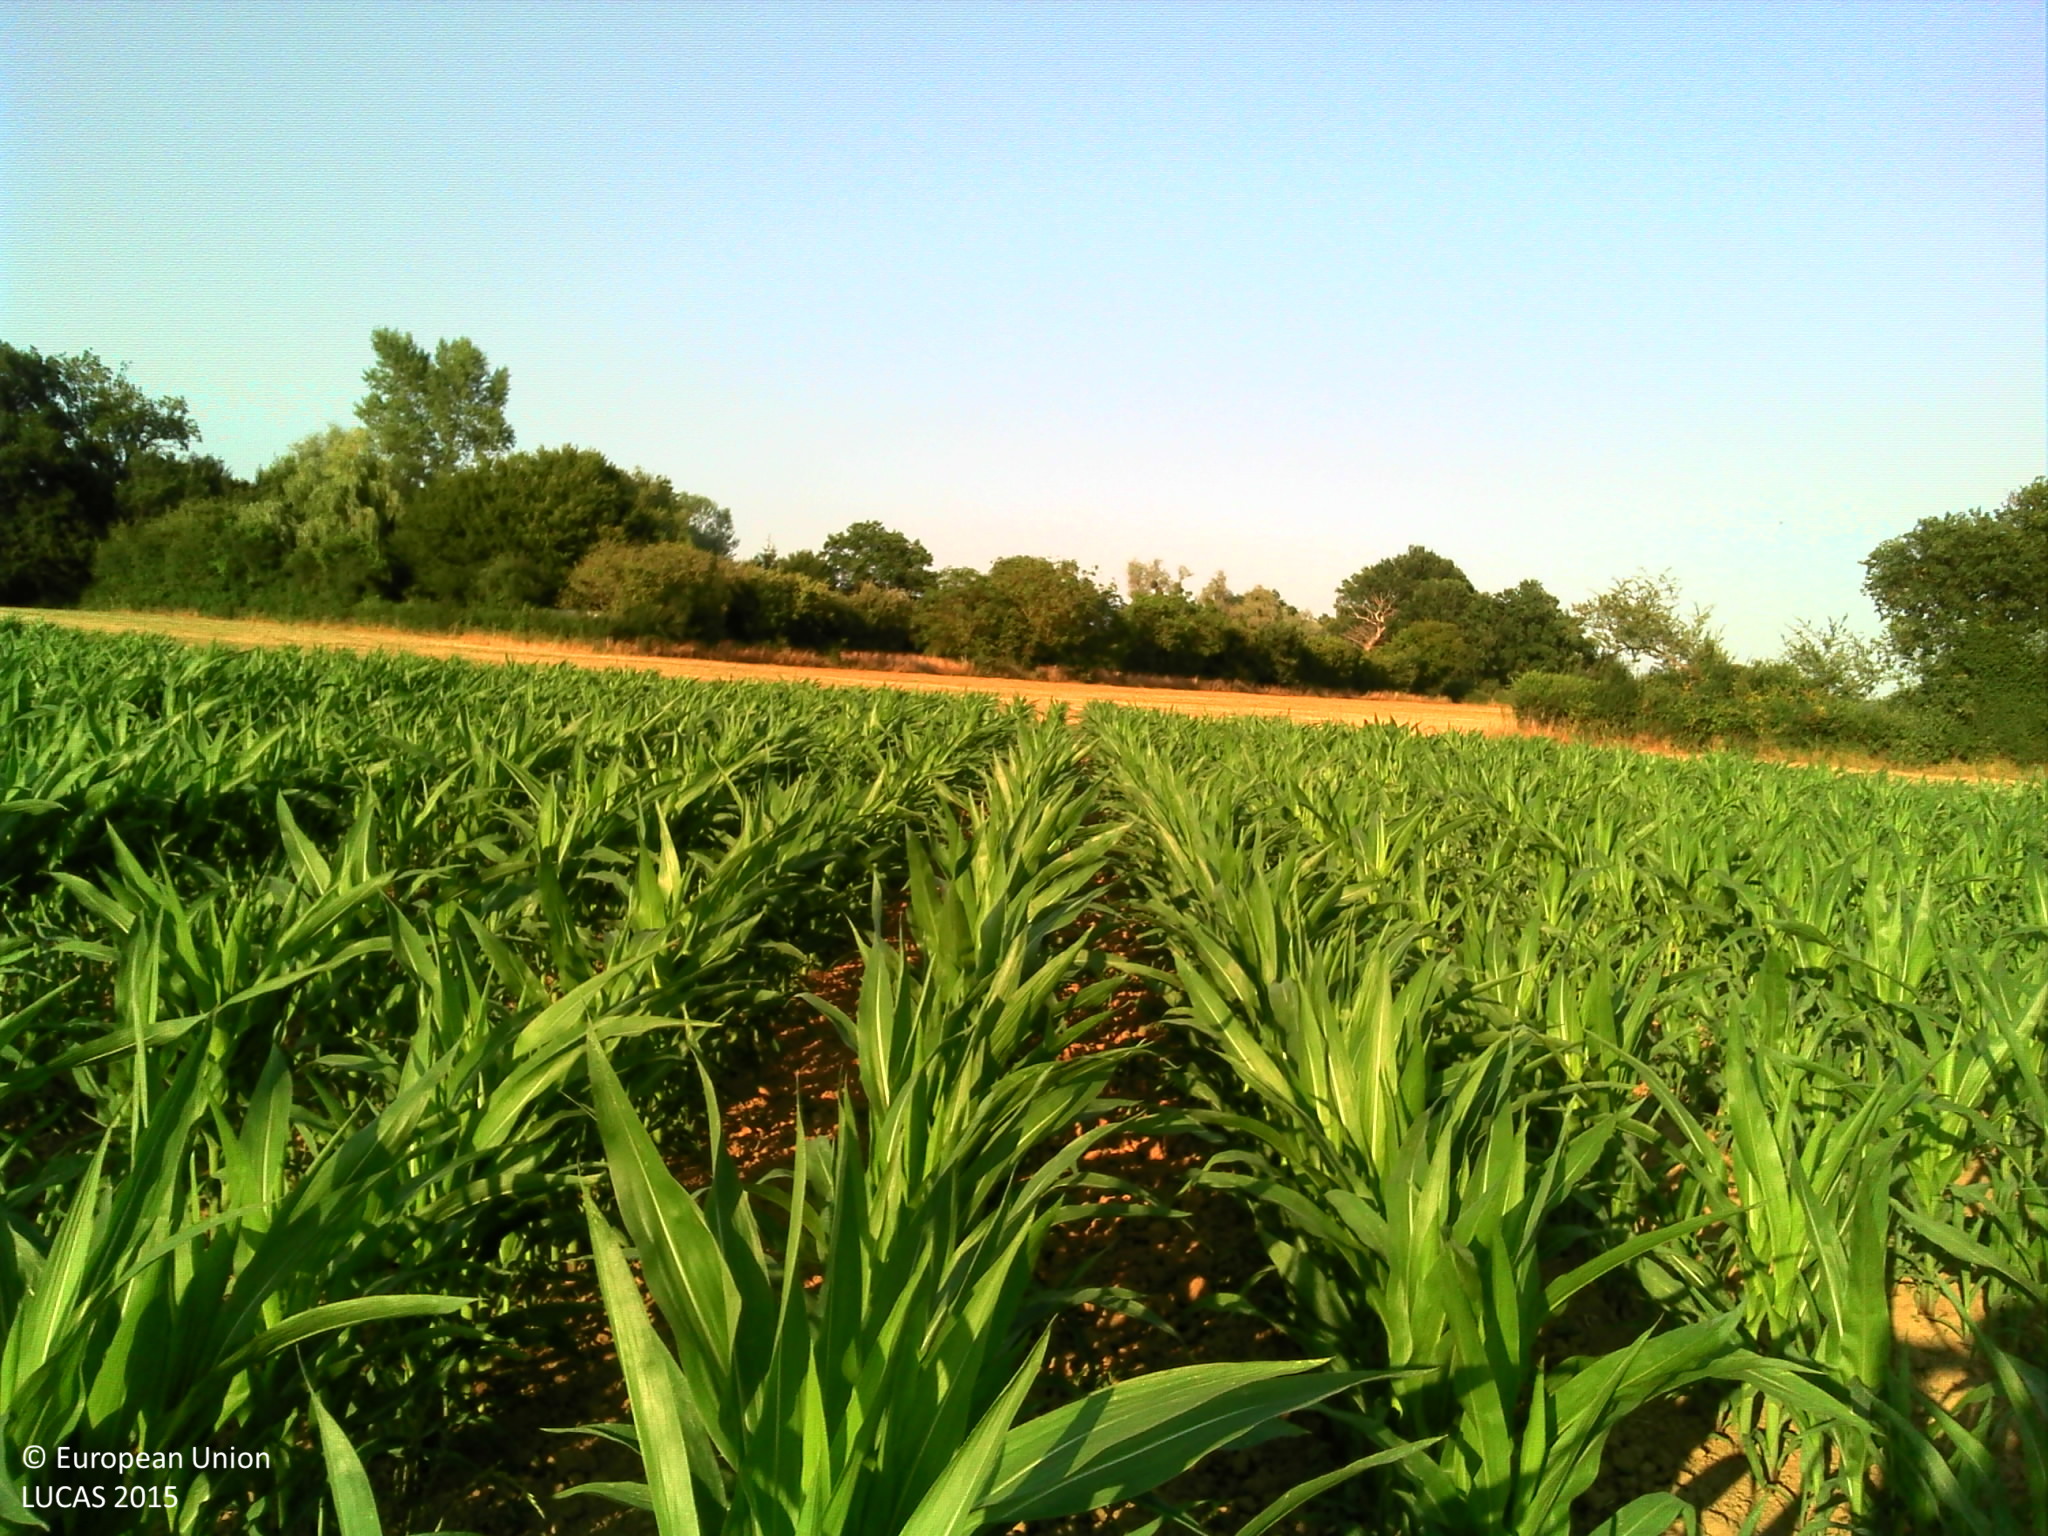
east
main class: Cropland
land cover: Maize
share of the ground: > 75 %
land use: Agriculture (excluding fallow land and kitchen gardens)
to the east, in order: Maize; Grassland without tree/shrub cover; Lines of trees; Grassland without tree/shrub cover; Abandoned hedges; Grass margins; Paved roads, cycling and walking lanes; Grass margins; Abandoned hedges; Grassland without tree/shrub cover
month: July
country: FR
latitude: 46.7897
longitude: 3.5662
